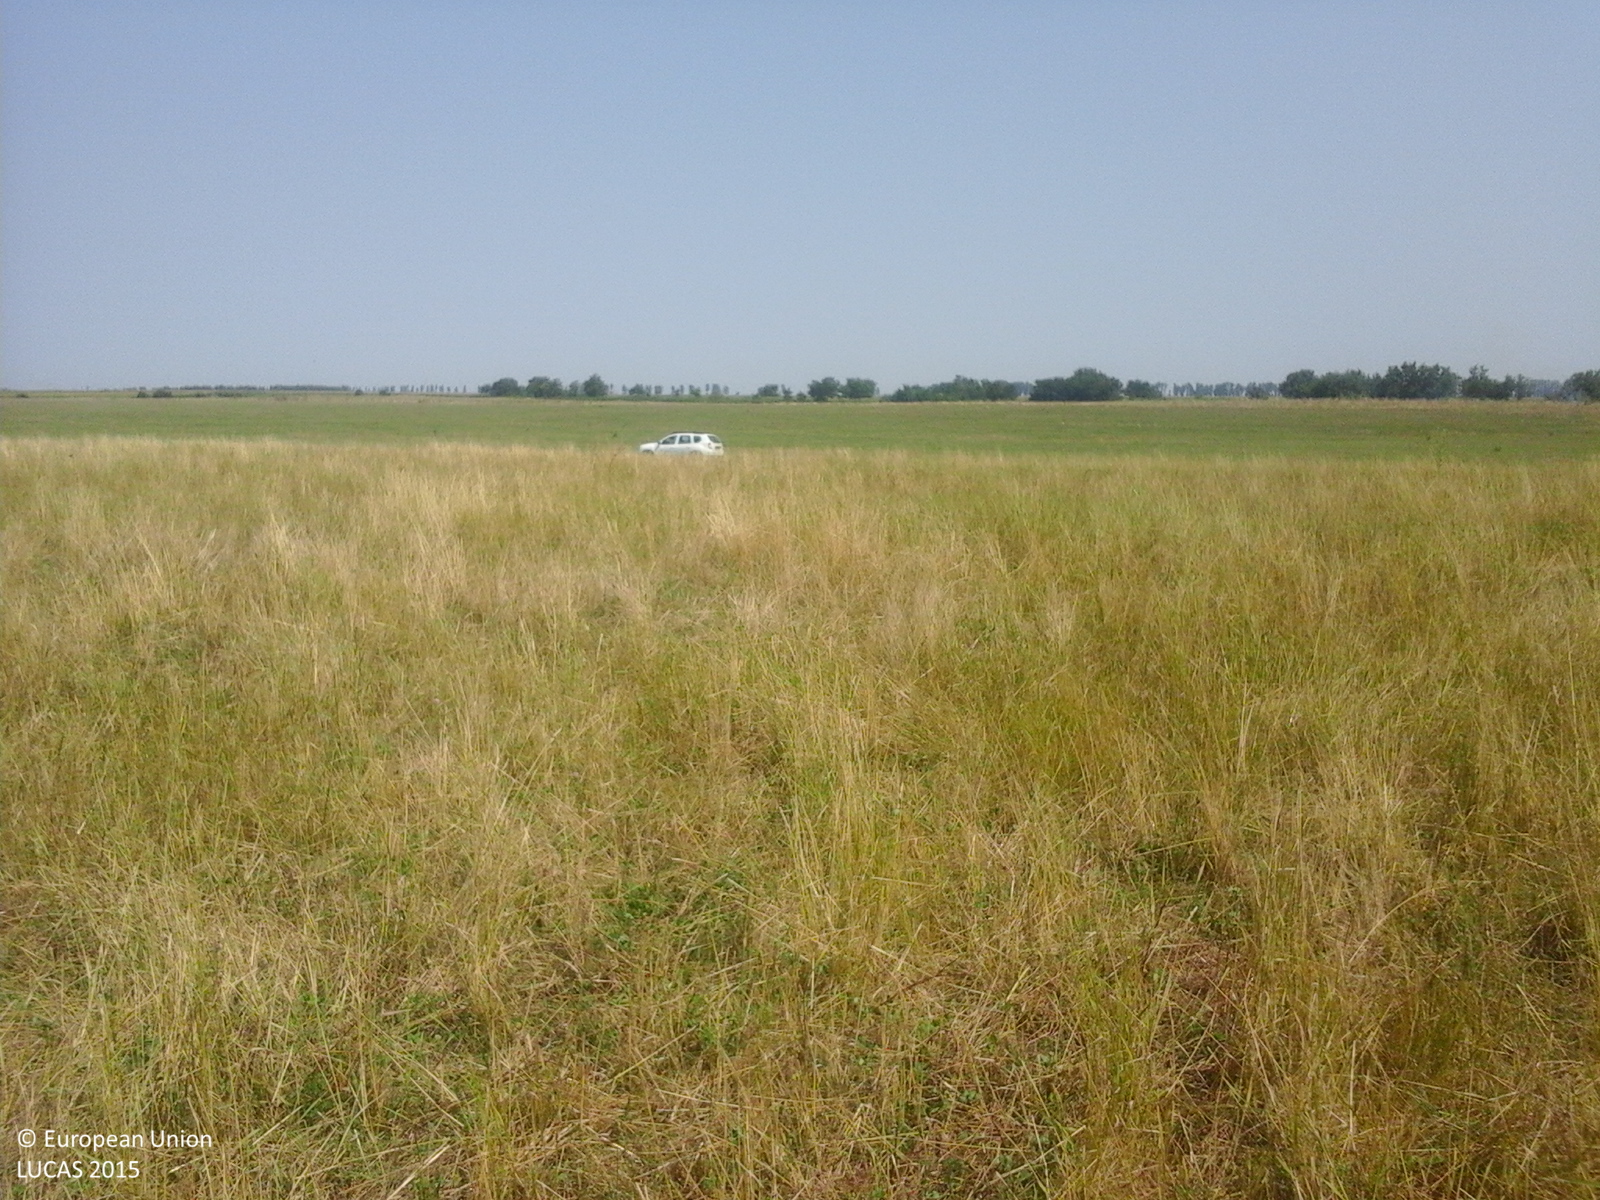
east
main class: Grassland
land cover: Grassland without tree/shrub cover
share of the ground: > 75 %
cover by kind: herbaceous plants 100 %
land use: Agriculture (excluding fallow land and kitchen gardens)
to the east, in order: Grassland without tree/shrub cover; Tracks; Grassland without tree/shrub cover
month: July
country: RO
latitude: 44.8424
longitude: 26.8144
